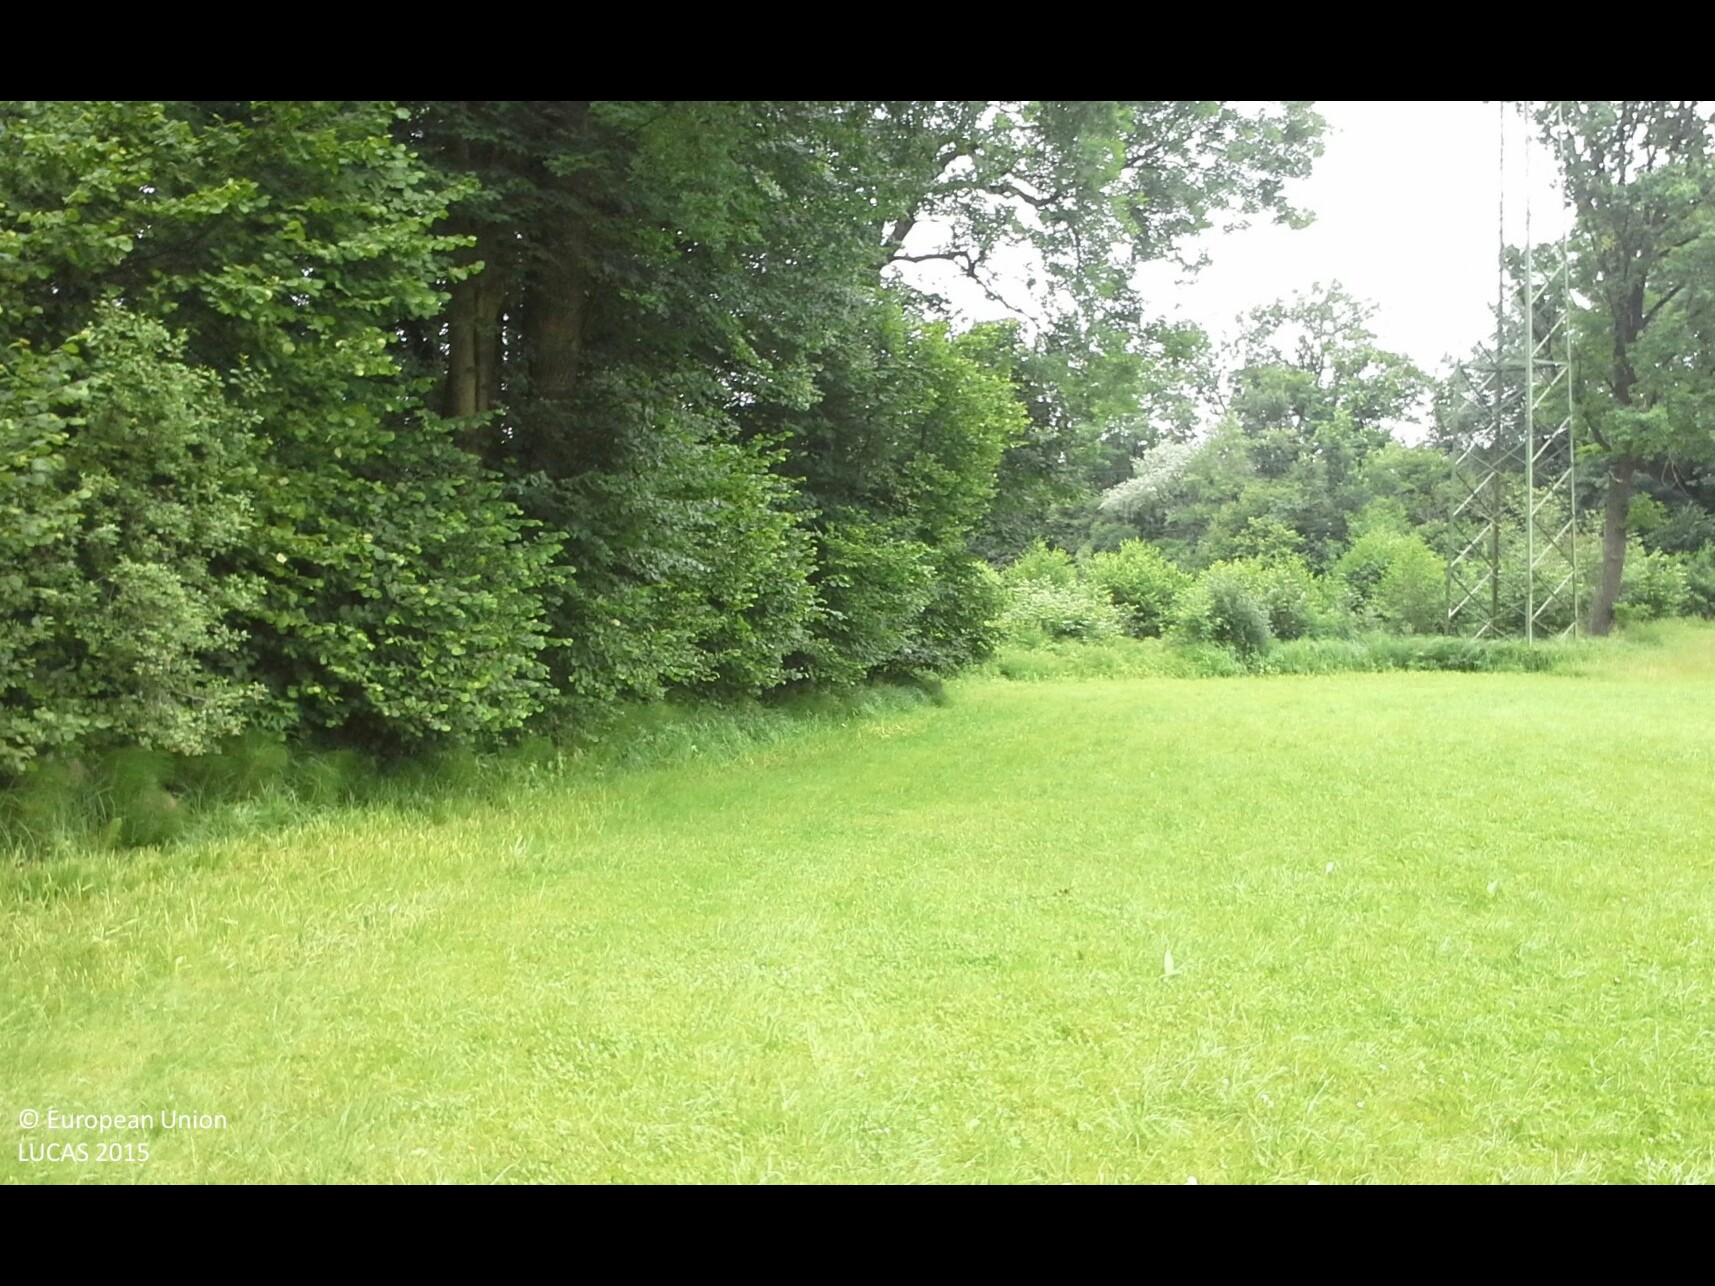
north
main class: Grassland
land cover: Grassland without tree/shrub cover
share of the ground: > 75 %
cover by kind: herbaceous plants 100 %
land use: Agriculture (excluding fallow land and kitchen gardens)
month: June
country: AT
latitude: 48.0733
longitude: 14.6039
